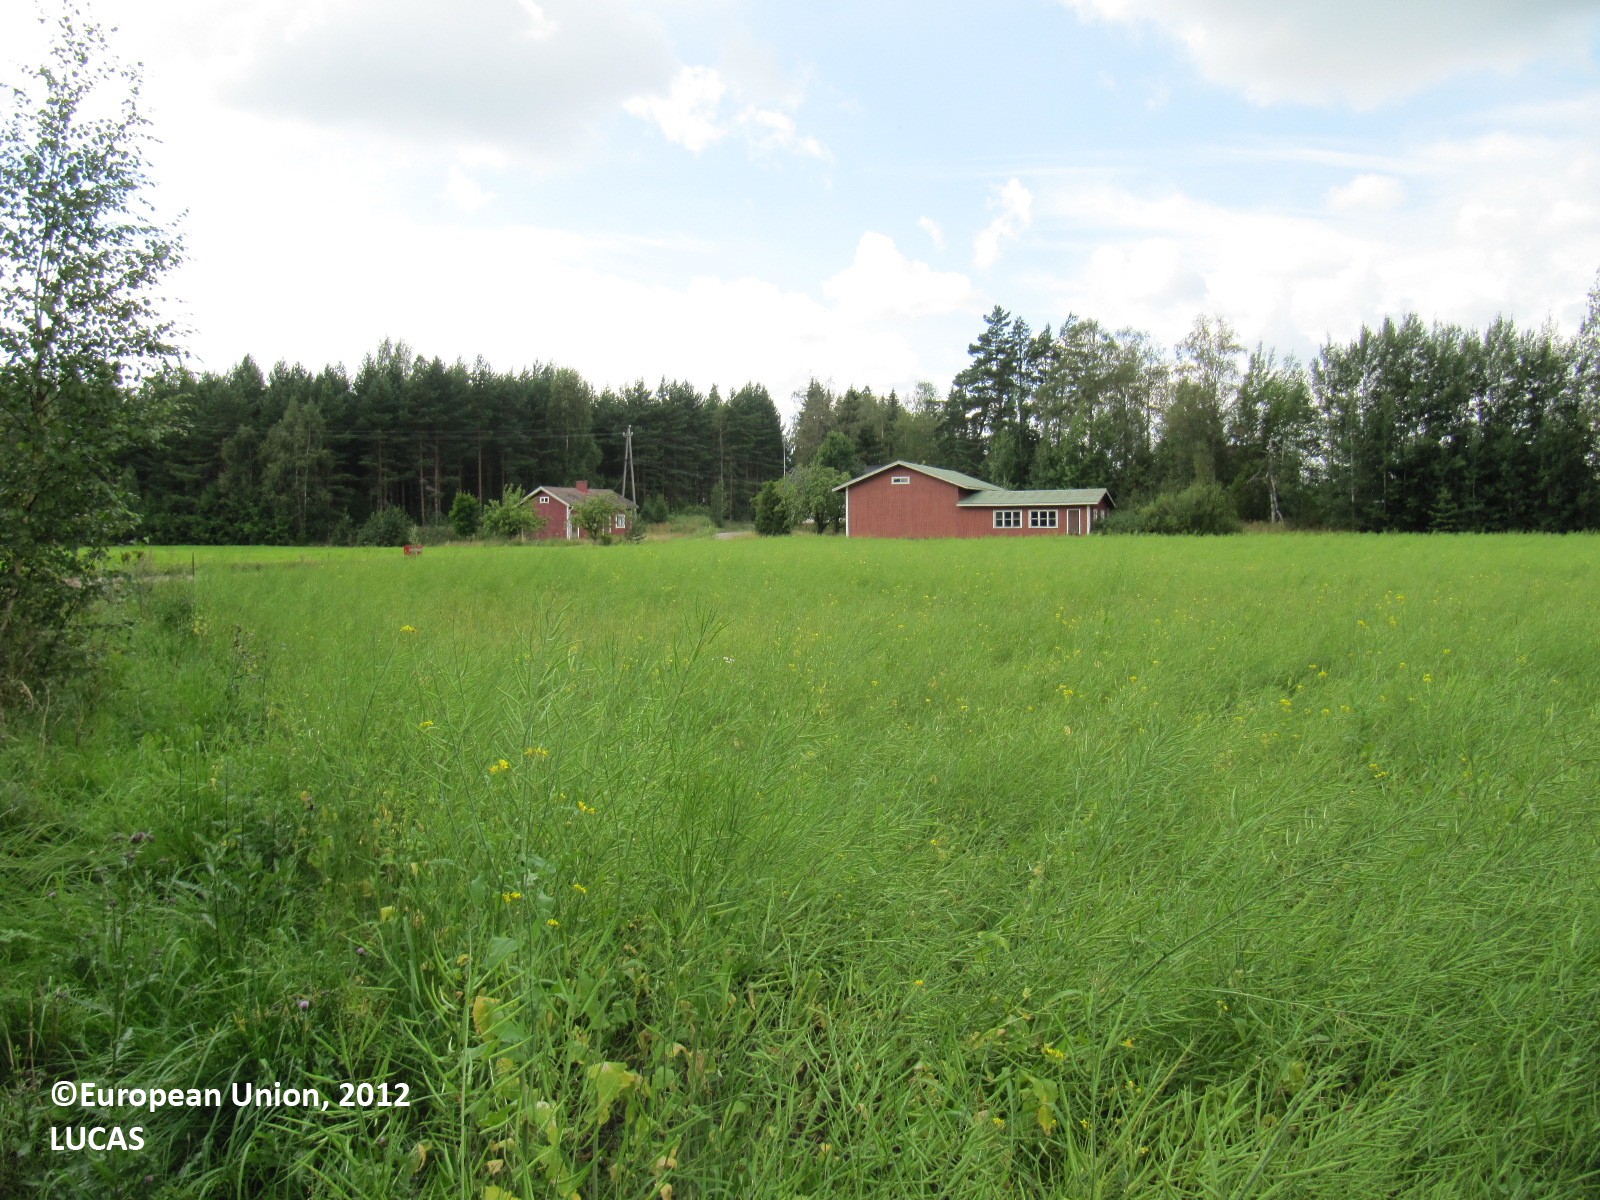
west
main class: Cropland
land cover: Rape and turnip rape
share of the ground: > 75 %
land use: Agriculture (excluding fallow land and kitchen gardens)
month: August
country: FI
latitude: 60.4155
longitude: 23.2106
